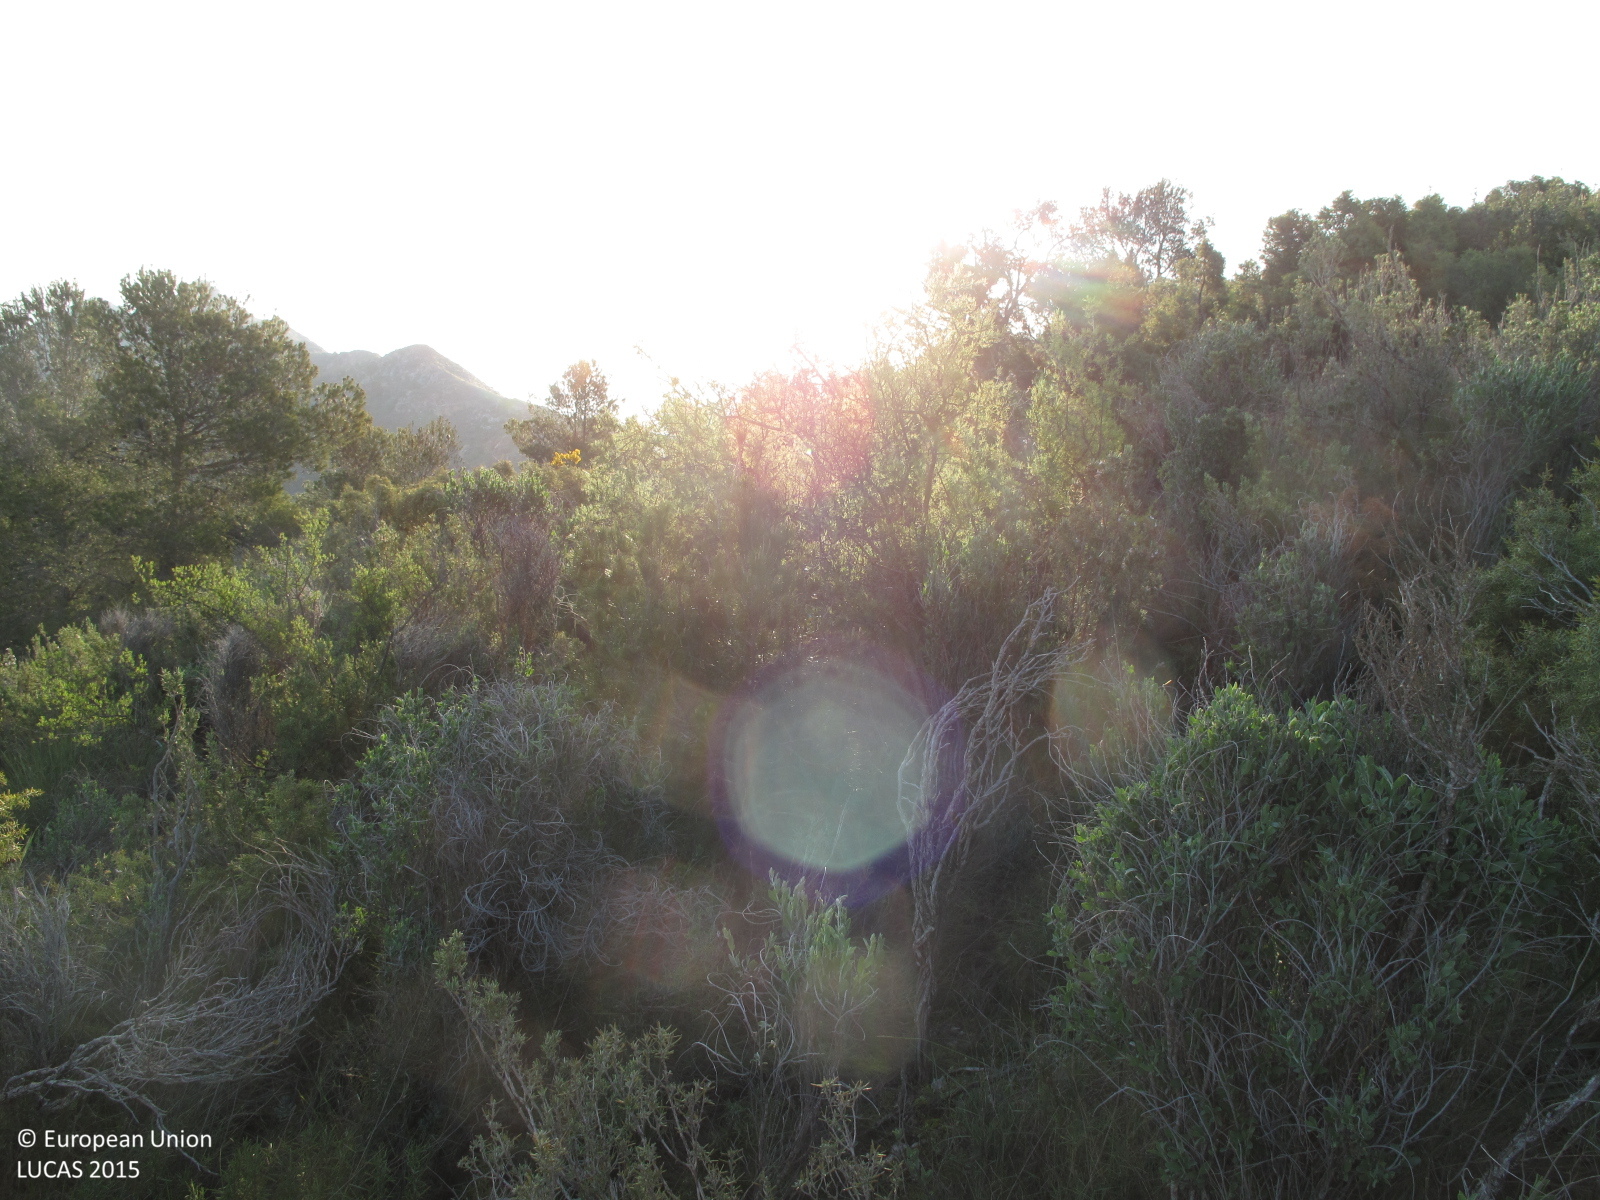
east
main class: Shrubland
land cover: Shrubland with sparse tree cover
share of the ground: > 75 %
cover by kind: shrubs 70 %, herbaceous plants 20 %, coniferous forest trees 5 %, consolidated bare surface 5 %
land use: Semi-natural and natural areas not in use
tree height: < 5 m
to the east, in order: Shrubland with sparse tree cover; Shrubland without tree cover; Shrubland with sparse tree cover
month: April
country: ES
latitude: 38.5290
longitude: -1.0364
